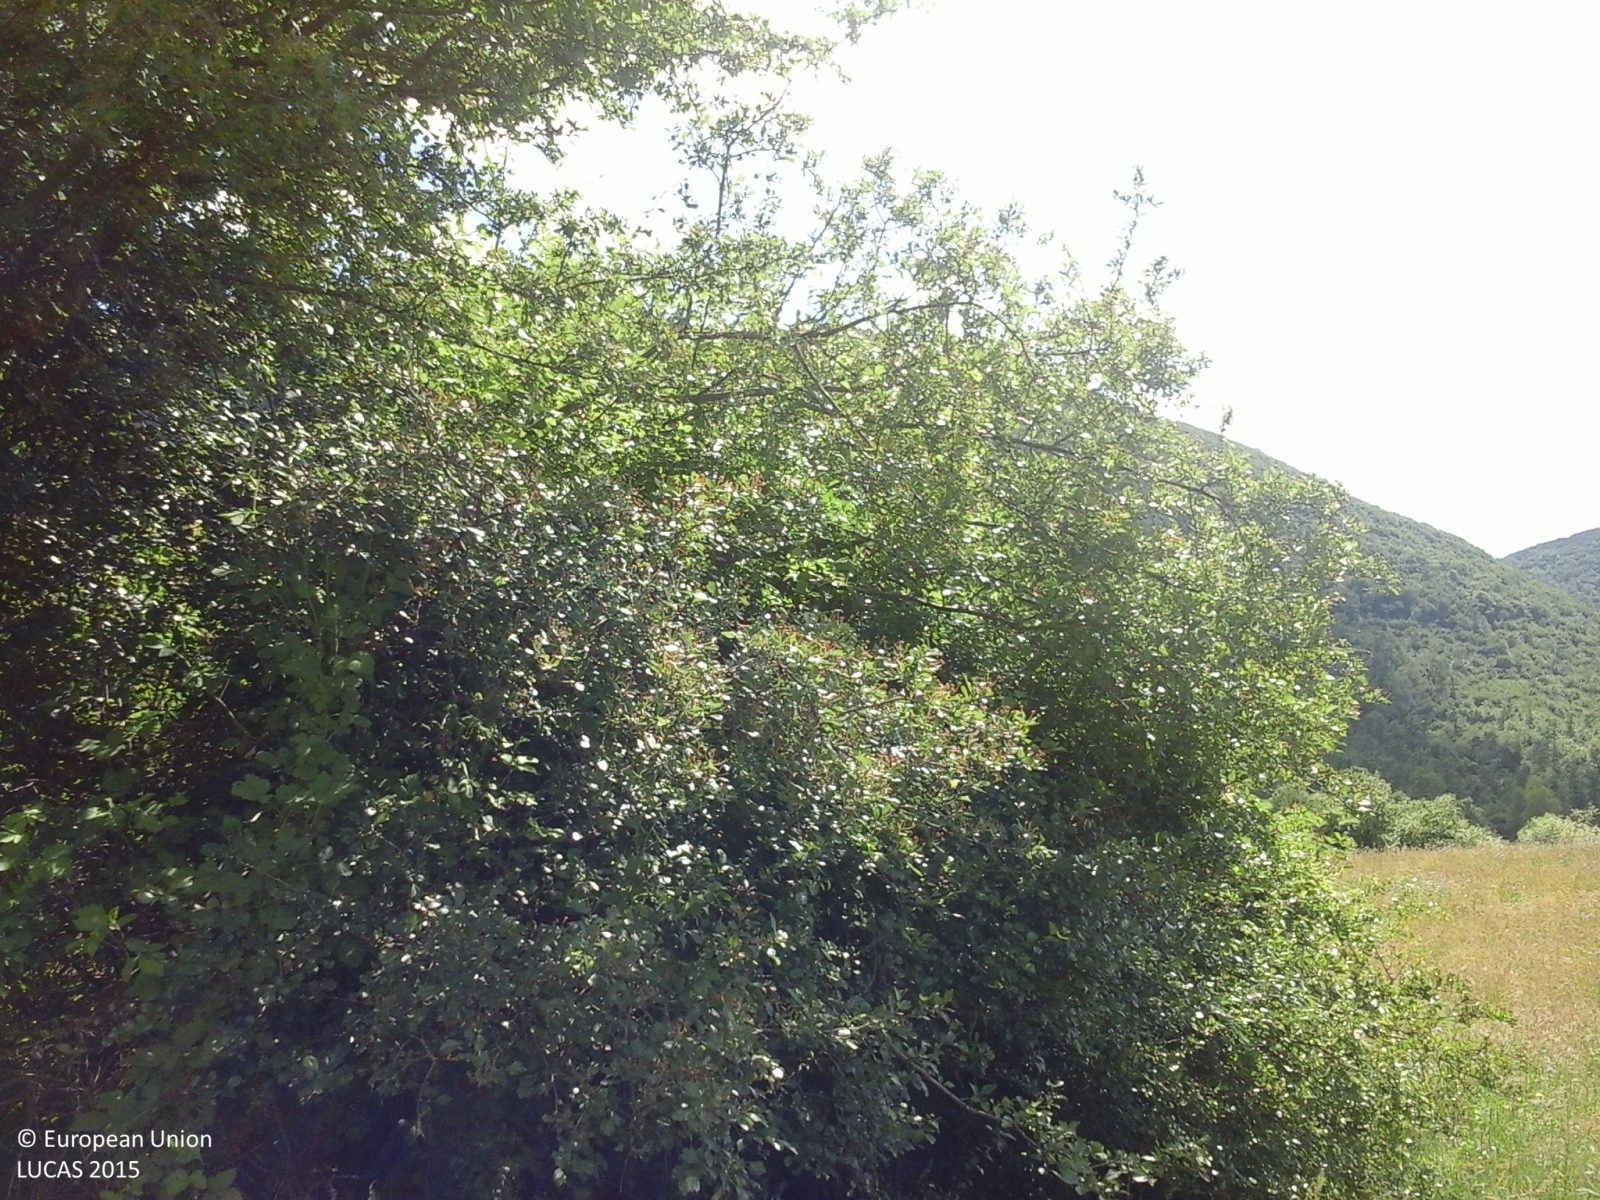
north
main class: Grassland
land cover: Grassland without tree/shrub cover
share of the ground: > 75 %
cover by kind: herbaceous plants 100 %
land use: Agriculture (excluding fallow land and kitchen gardens)
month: May
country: IT
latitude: 41.7710
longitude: 13.2241
